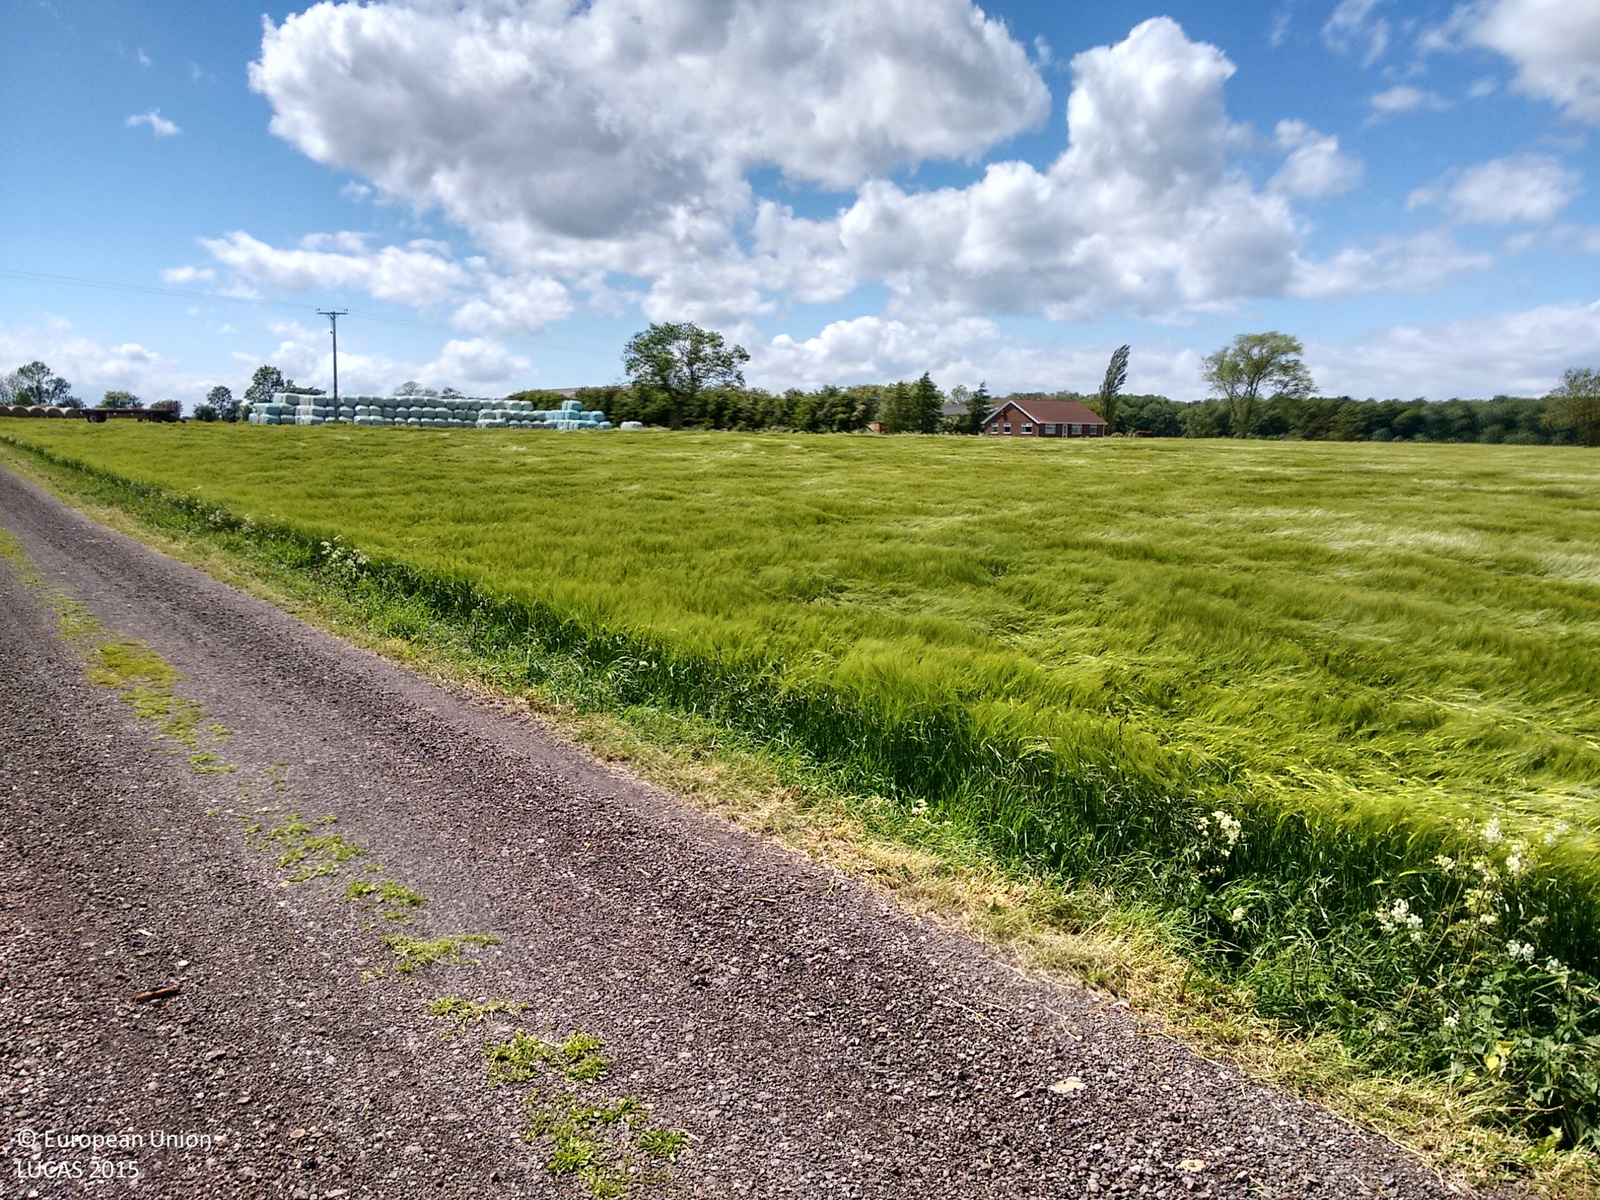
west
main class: Grassland
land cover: Grassland without tree/shrub cover
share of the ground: > 75 %
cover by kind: herbaceous plants 100 %
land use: Agriculture (excluding fallow land and kitchen gardens)
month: June
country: GB
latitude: 53.5839
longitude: -0.2302
